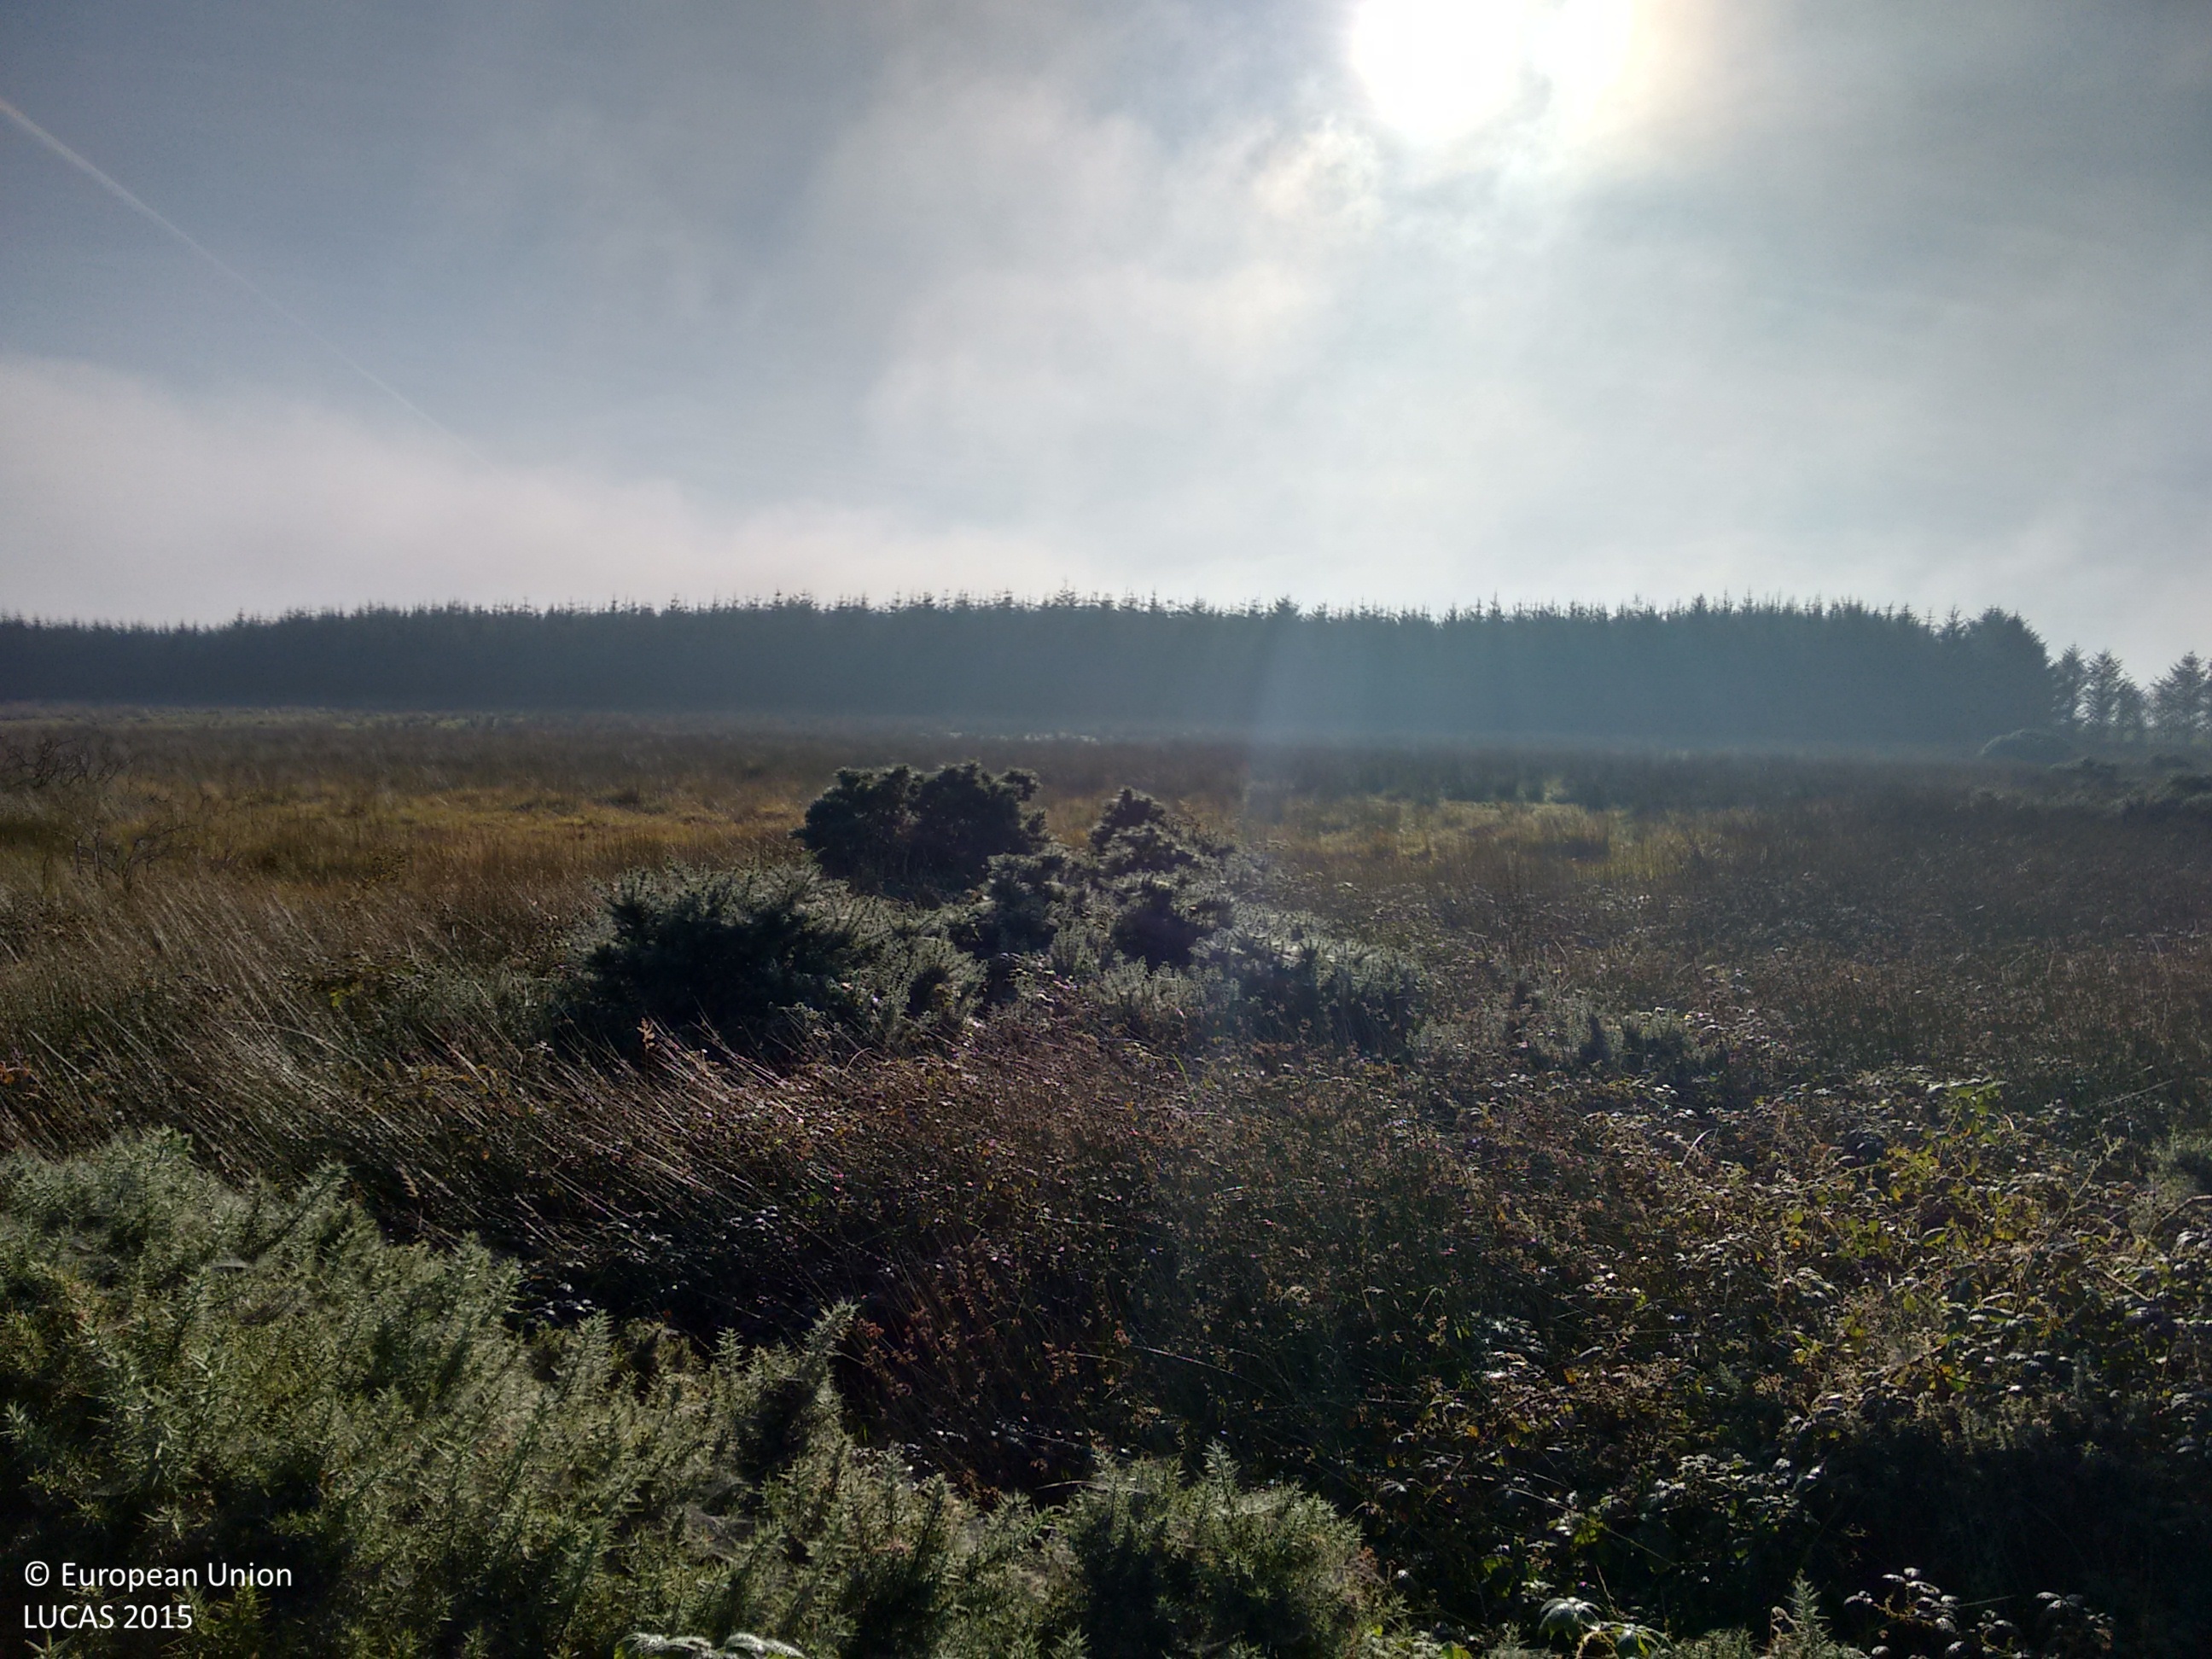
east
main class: Grassland
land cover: Grassland without tree/shrub cover
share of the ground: > 75 %
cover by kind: herbaceous plants 95 %, shrubs 5 %
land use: Agriculture (excluding fallow land and kitchen gardens)
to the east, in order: Grassland without tree/shrub cover; Fences; Pine dominated mixed woodland
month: September
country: IE
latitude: 52.4120
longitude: -9.2311
